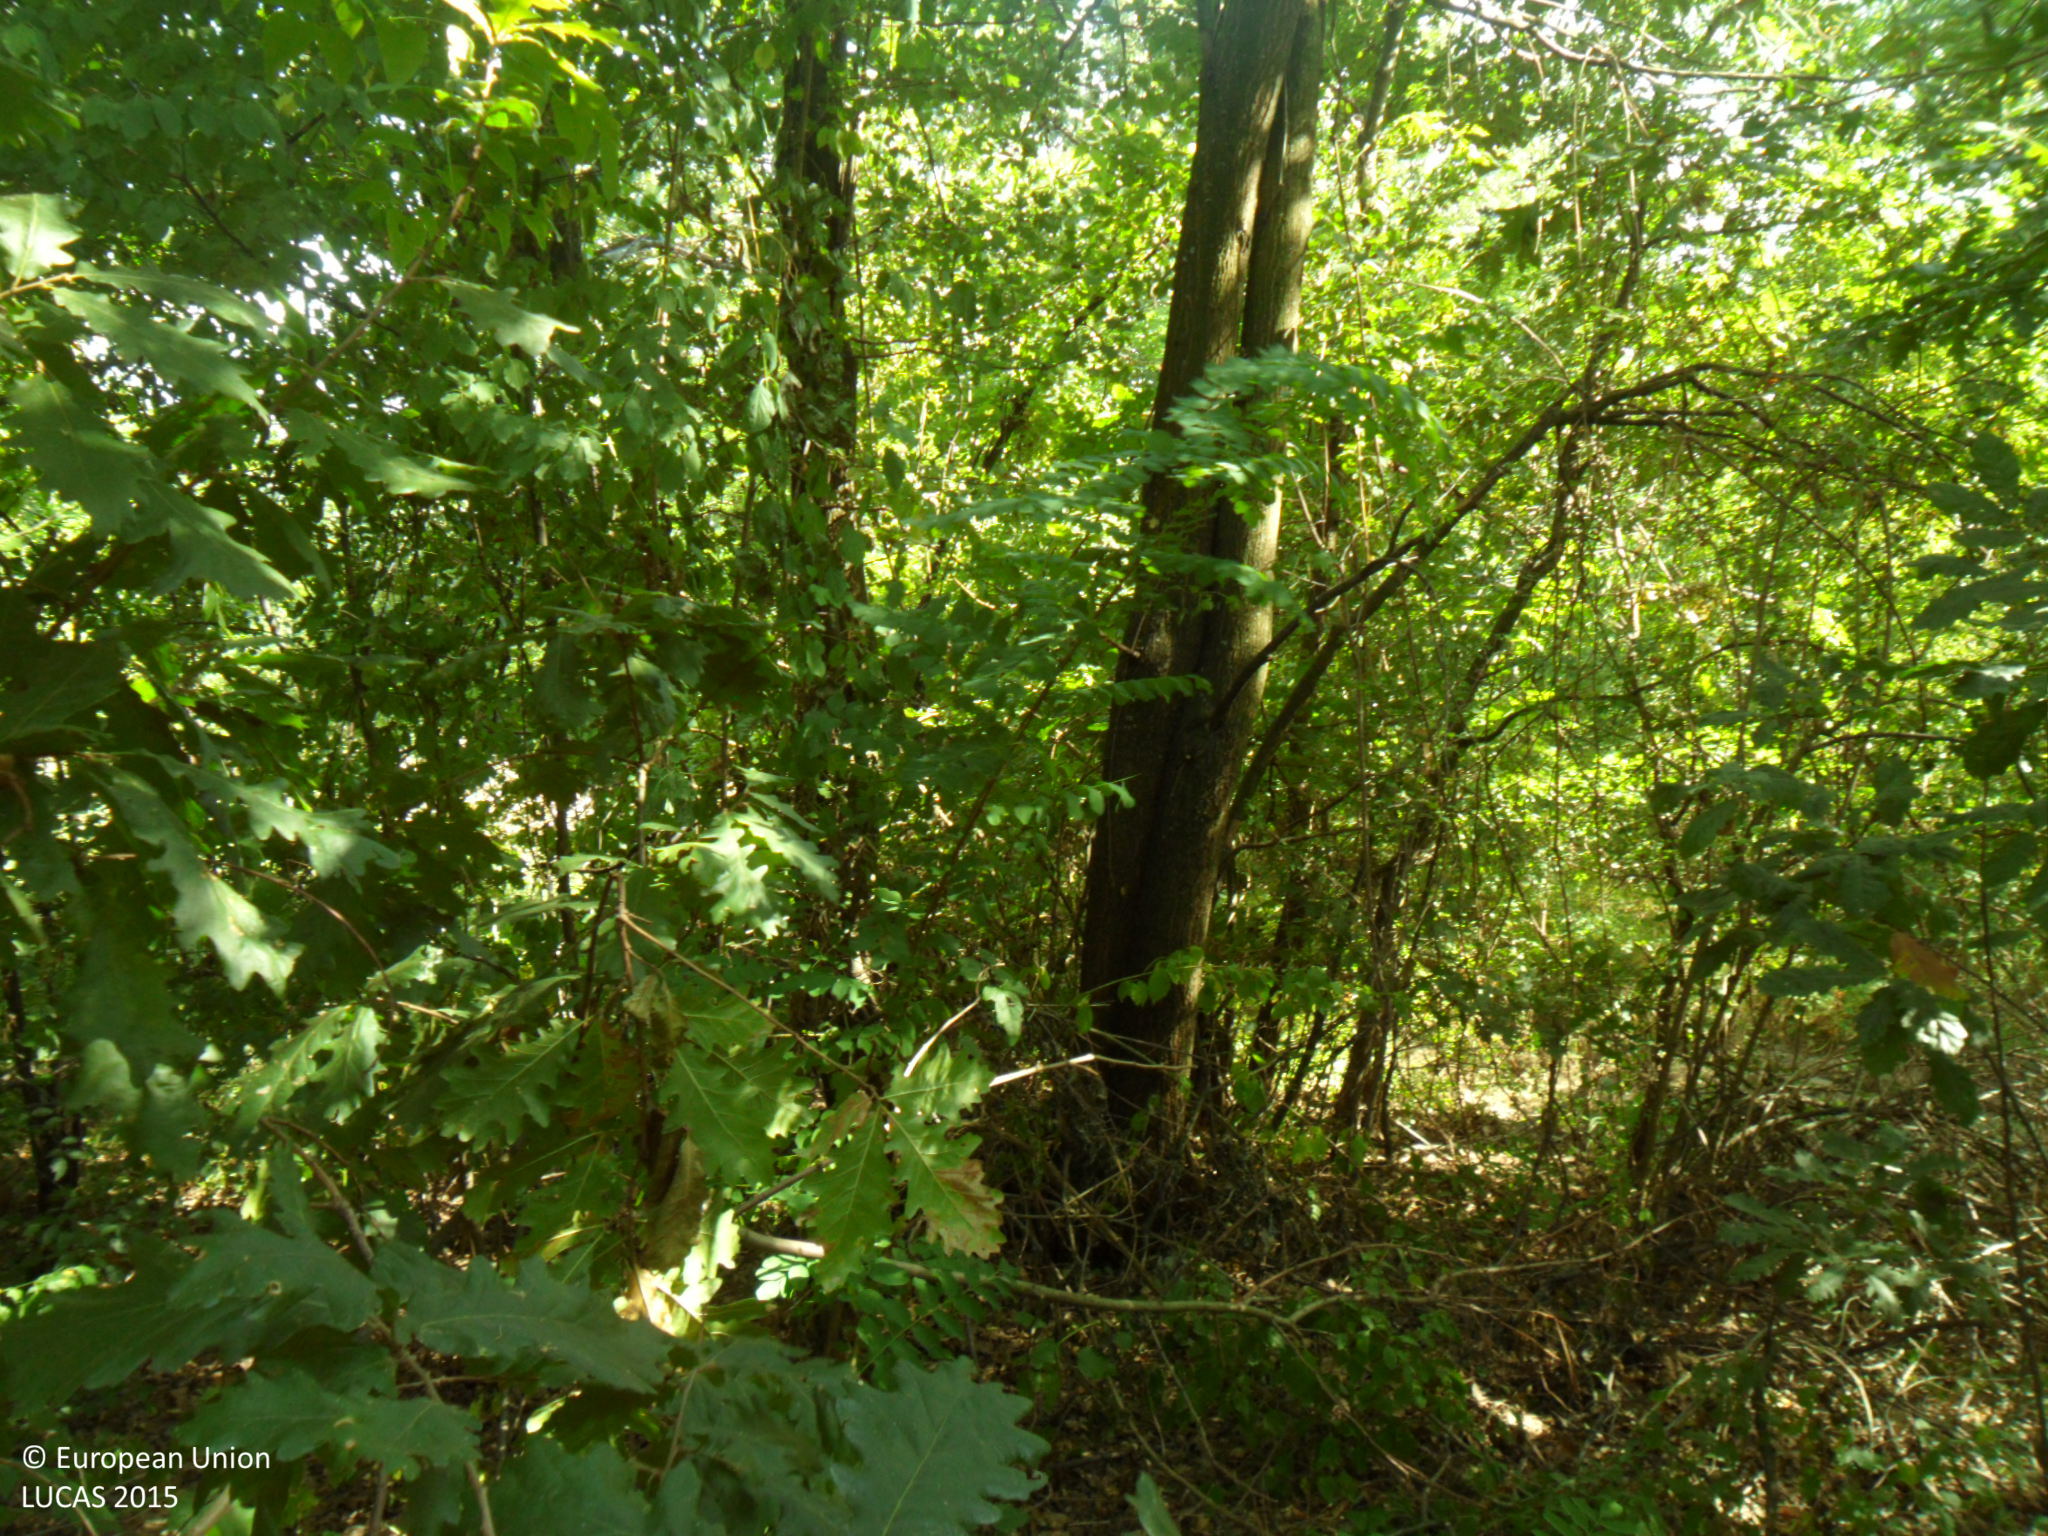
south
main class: Woodland
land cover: Broadleaved woodland
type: mesophytic deciduous forest
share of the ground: > 75 %
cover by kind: broadleaved forest trees 95 %, unconsolidated bare surface 5 %
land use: Forestry
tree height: > 5 m
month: August
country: BG
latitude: 43.5189
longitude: 26.6998
